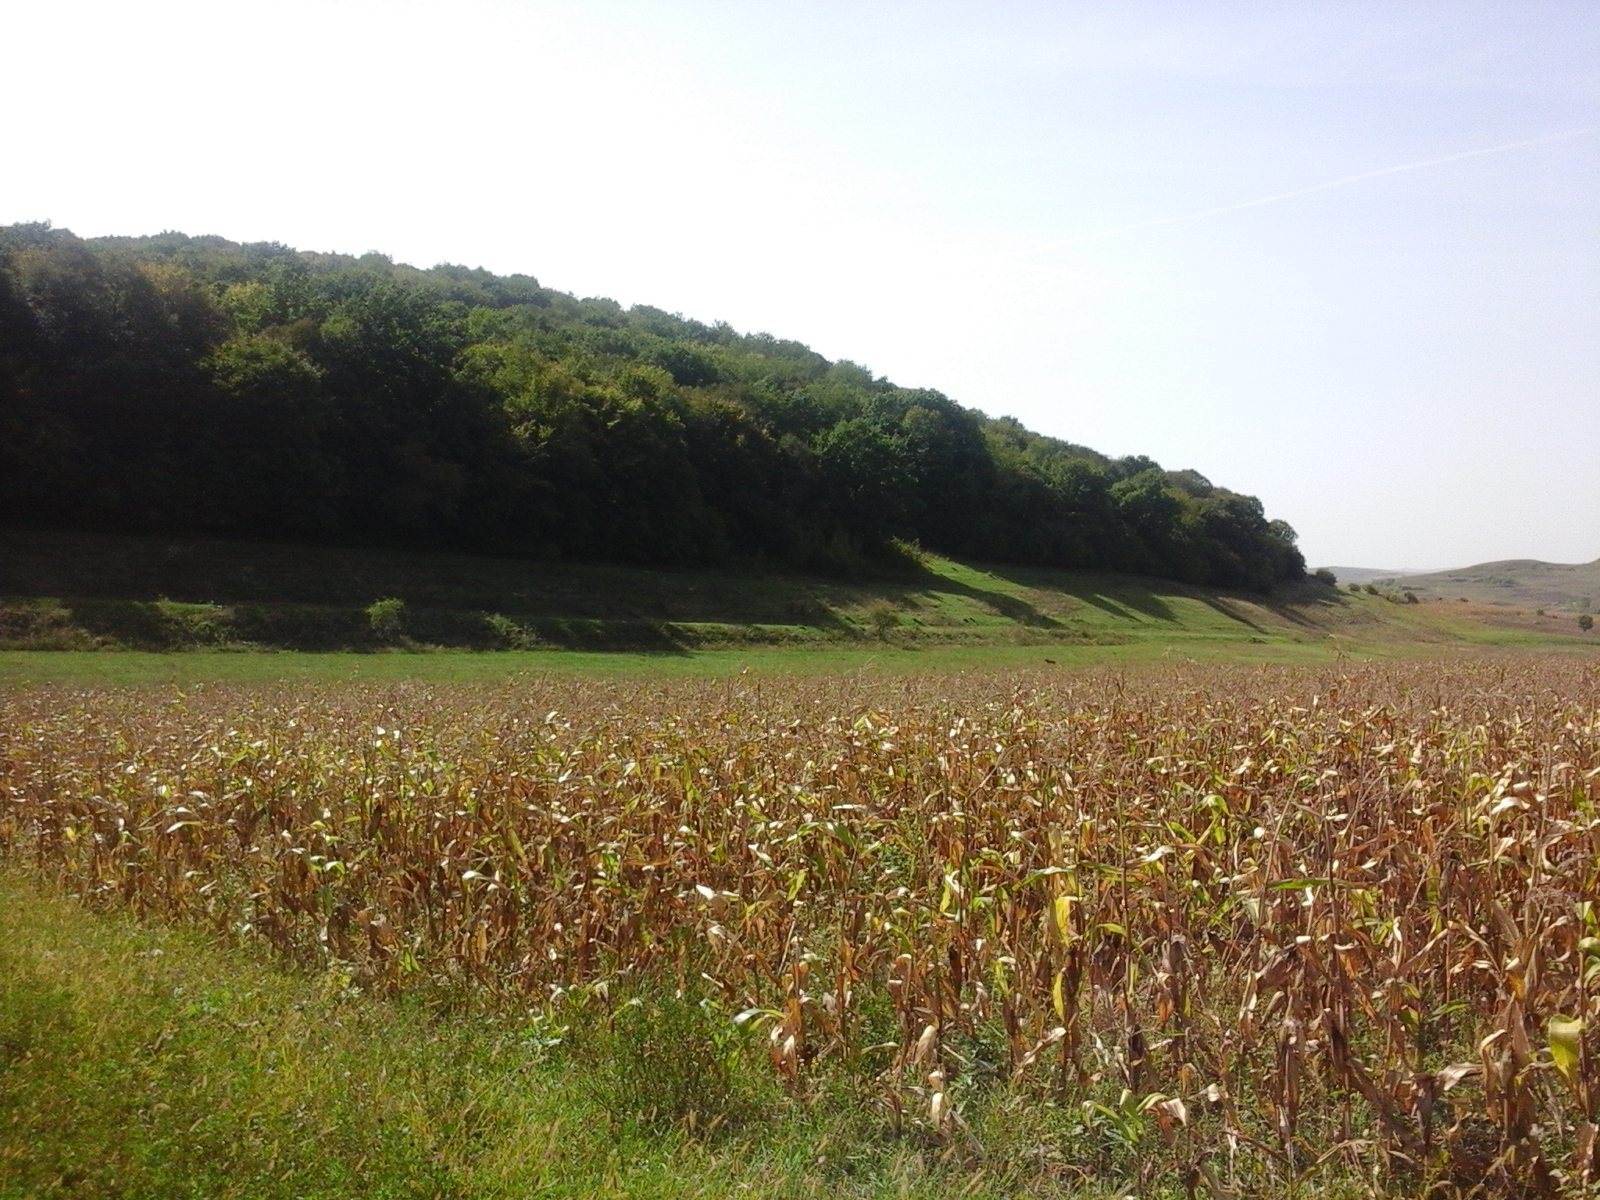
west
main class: Cropland
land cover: Maize
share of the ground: > 75 %
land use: Agriculture (excluding fallow land and kitchen gardens)
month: September
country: RO
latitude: 46.8641
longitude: 23.8904
